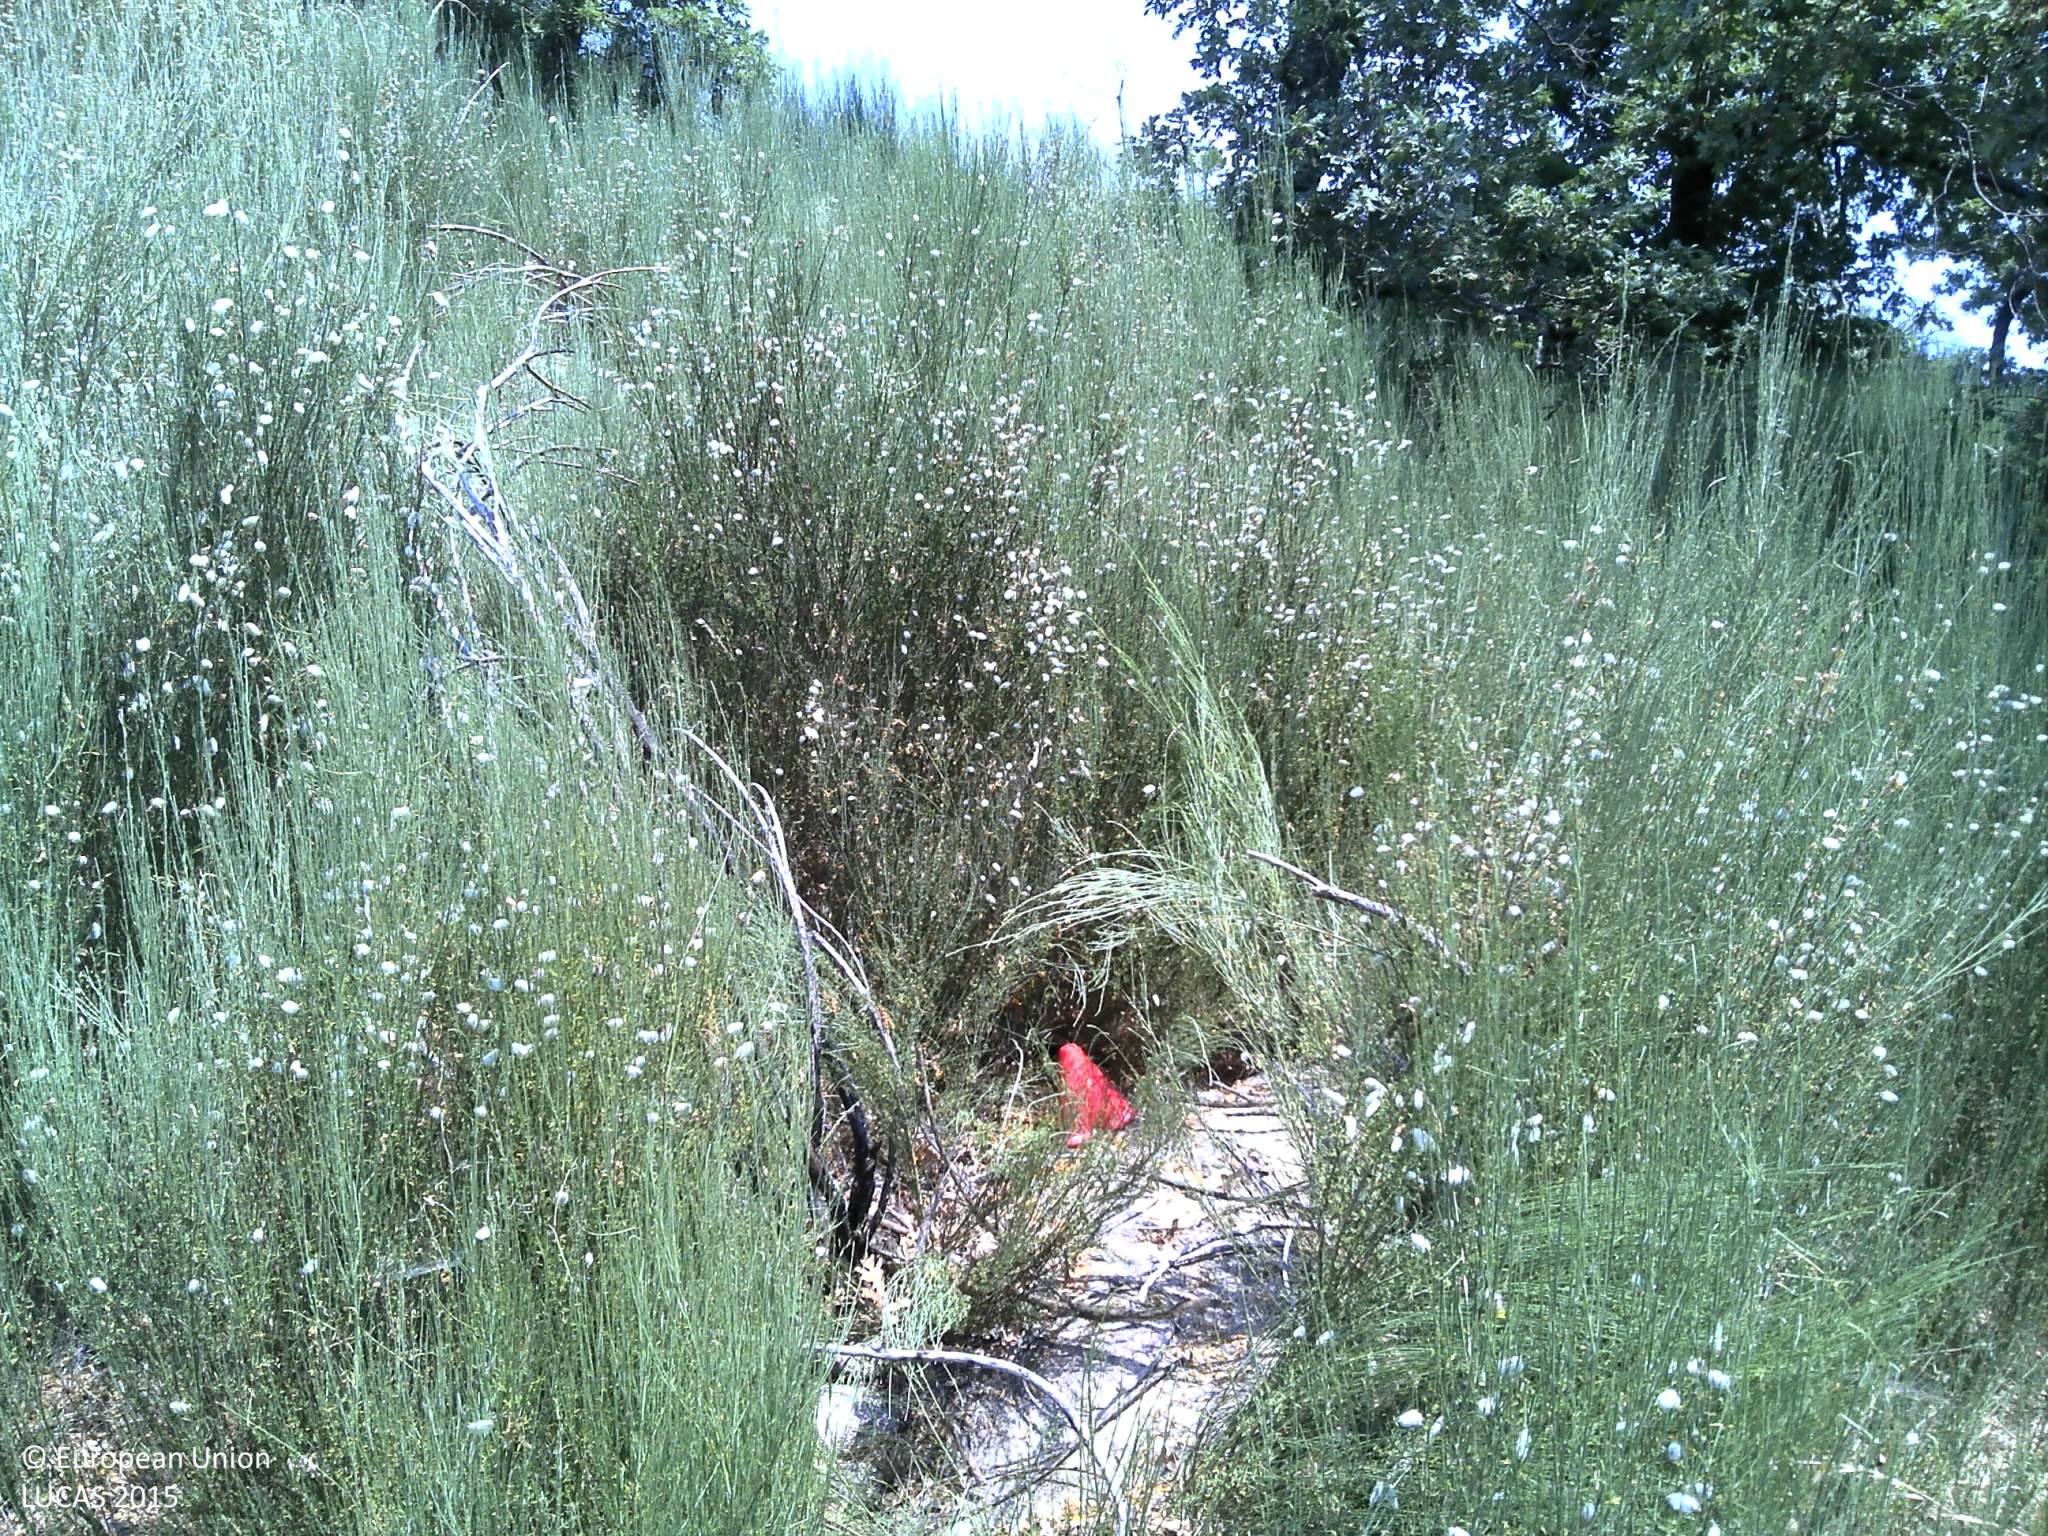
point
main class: Shrubland
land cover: Shrubland with sparse tree cover
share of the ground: > 75 %
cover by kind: shrubs 80 %, herbaceous plants 10 %, broadleaved forest trees 5 %, consolidated bare surface 5 %
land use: Semi-natural and natural areas not in use
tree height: > 5 m
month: June
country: PT
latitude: 41.4325
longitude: -7.5884
